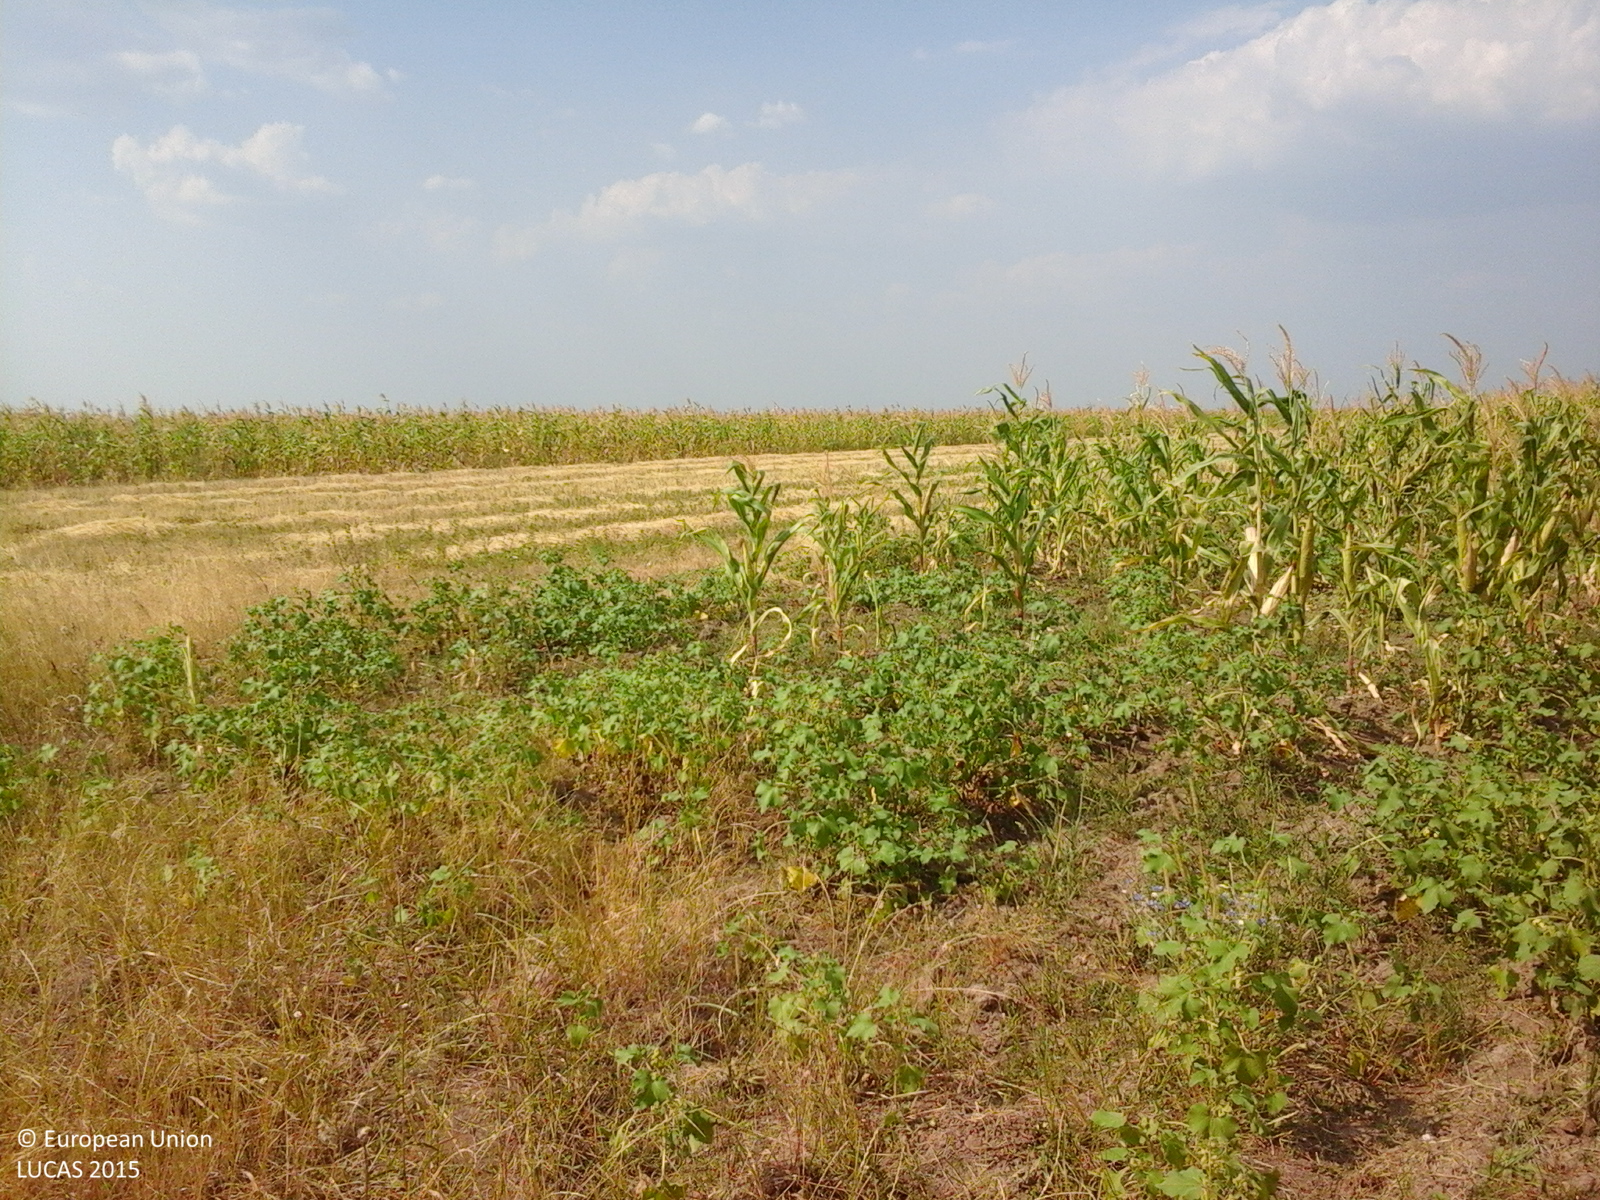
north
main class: Grassland
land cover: Spontaneously vegetated surfaces
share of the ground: > 75 %
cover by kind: herbaceous plants 100 %
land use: Fallow land
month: August
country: RO
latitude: 44.4257
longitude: 23.1228
